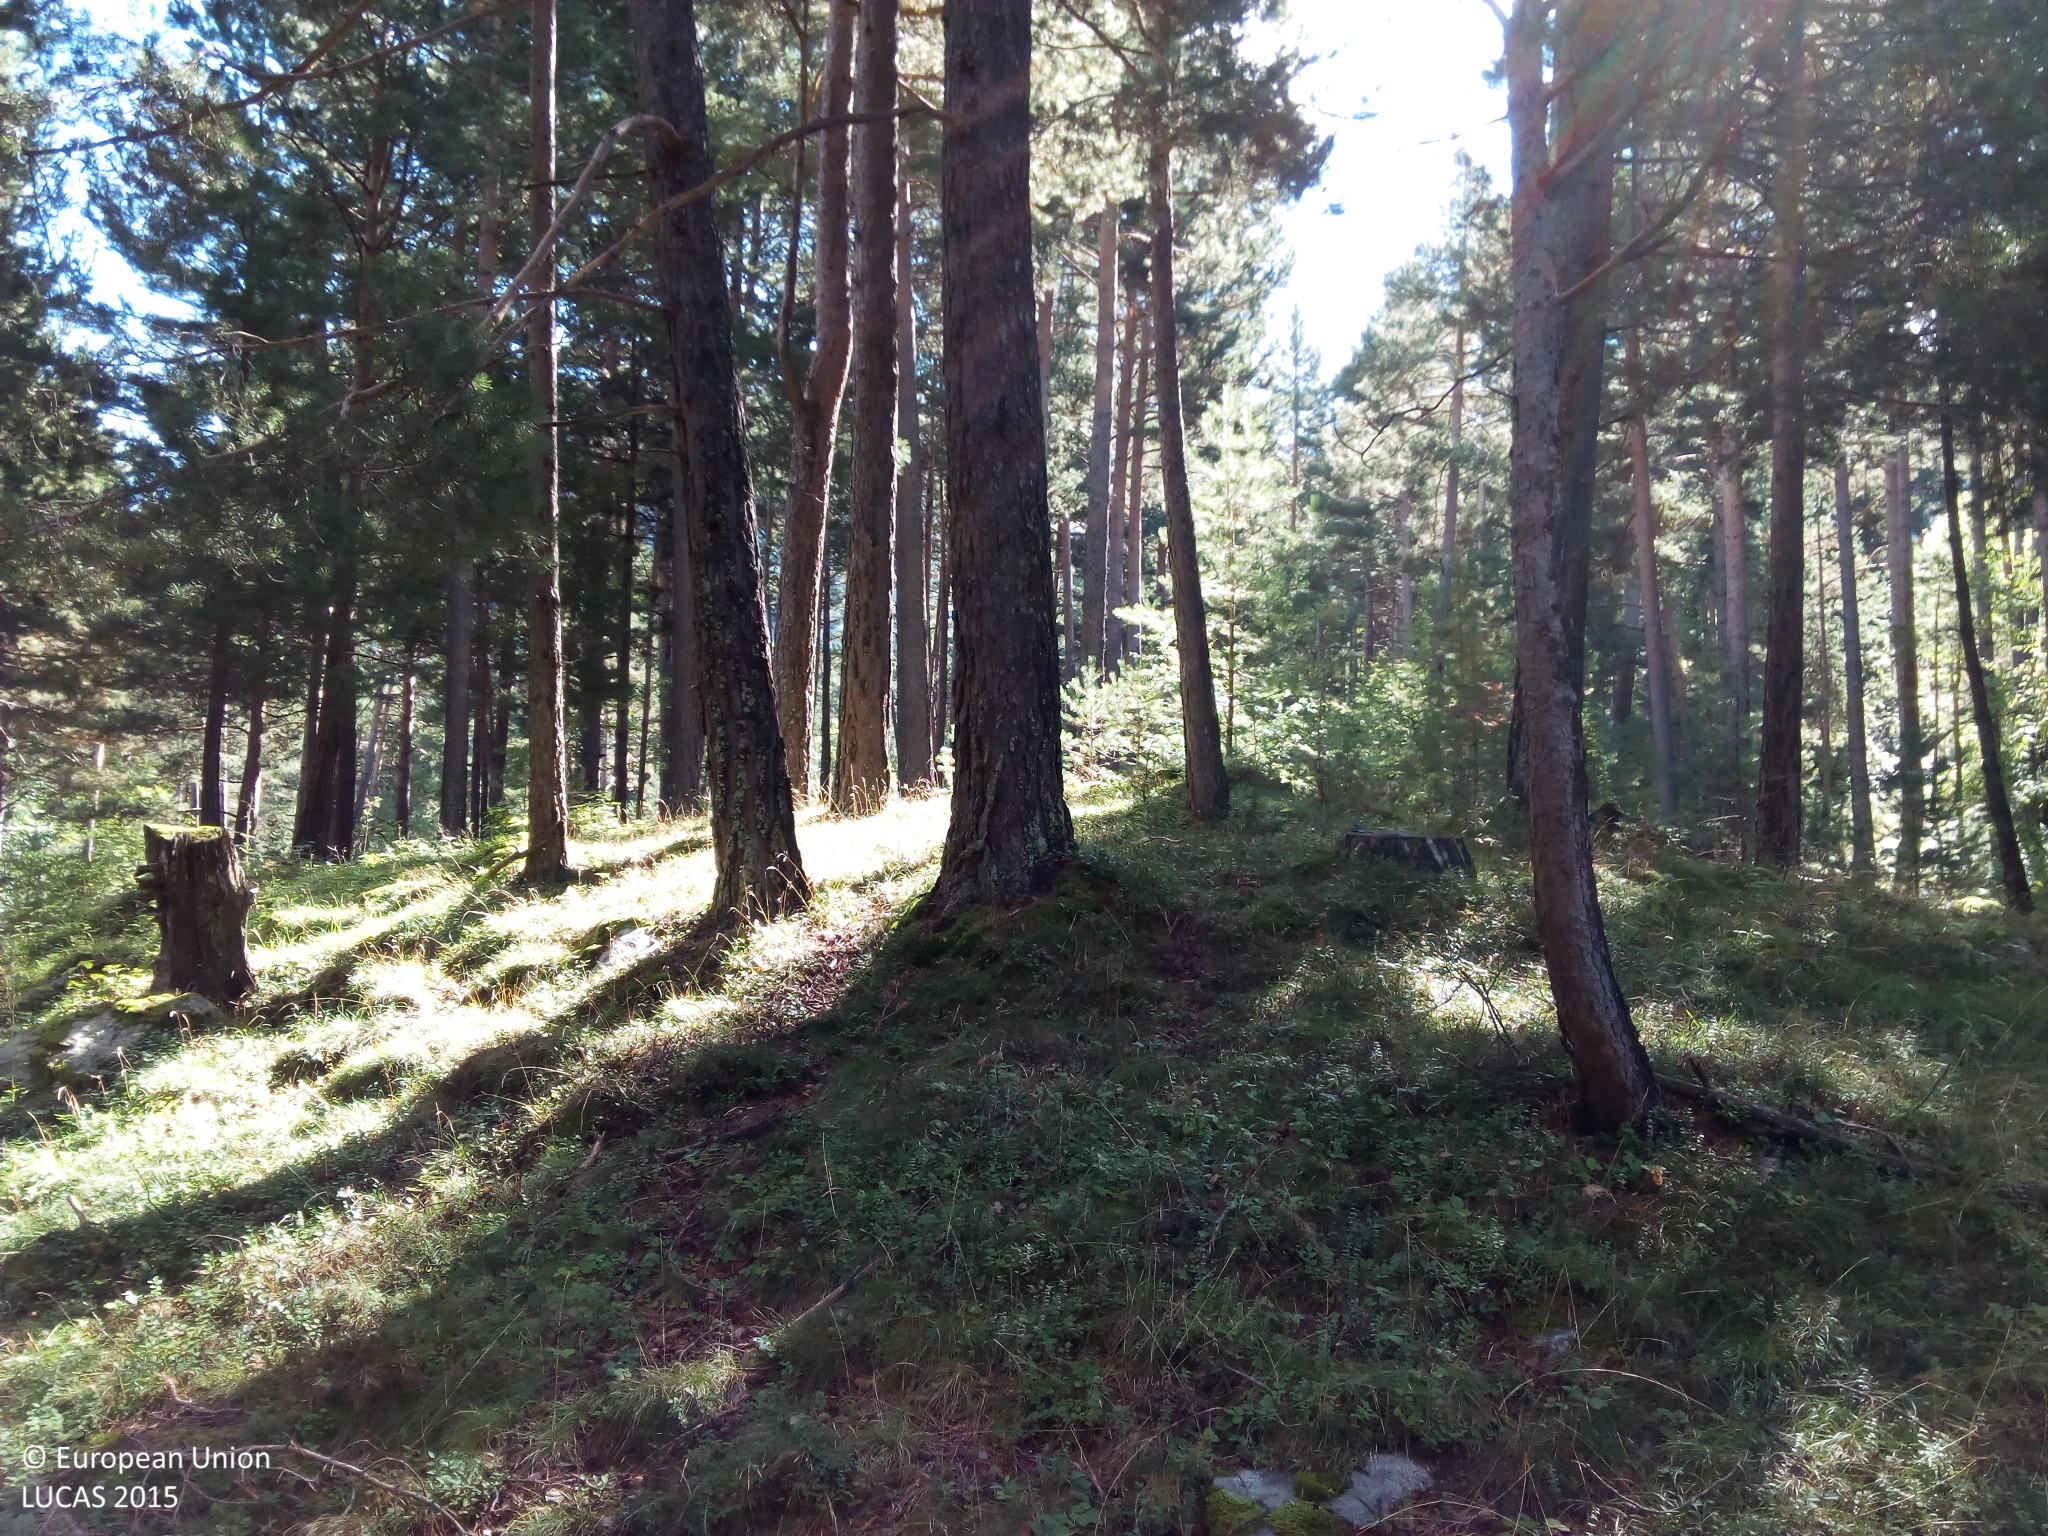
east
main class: Woodland
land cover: Pine dominated coniferous woodland
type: alpine coniferous forest
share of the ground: > 75 %
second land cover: Grassland without tree/shrub cover
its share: 10 - 25 %
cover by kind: coniferous forest trees 75 %, shrubs 15 %, herbaceous plants 10 %
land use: Forestry
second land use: Agriculture (excluding fallow land and kitchen gardens)
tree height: > 5 m
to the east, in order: Pine dominated coniferous woodland; Grassland without tree/shrub cover
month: September
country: ES
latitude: 42.6471
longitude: 0.3549
